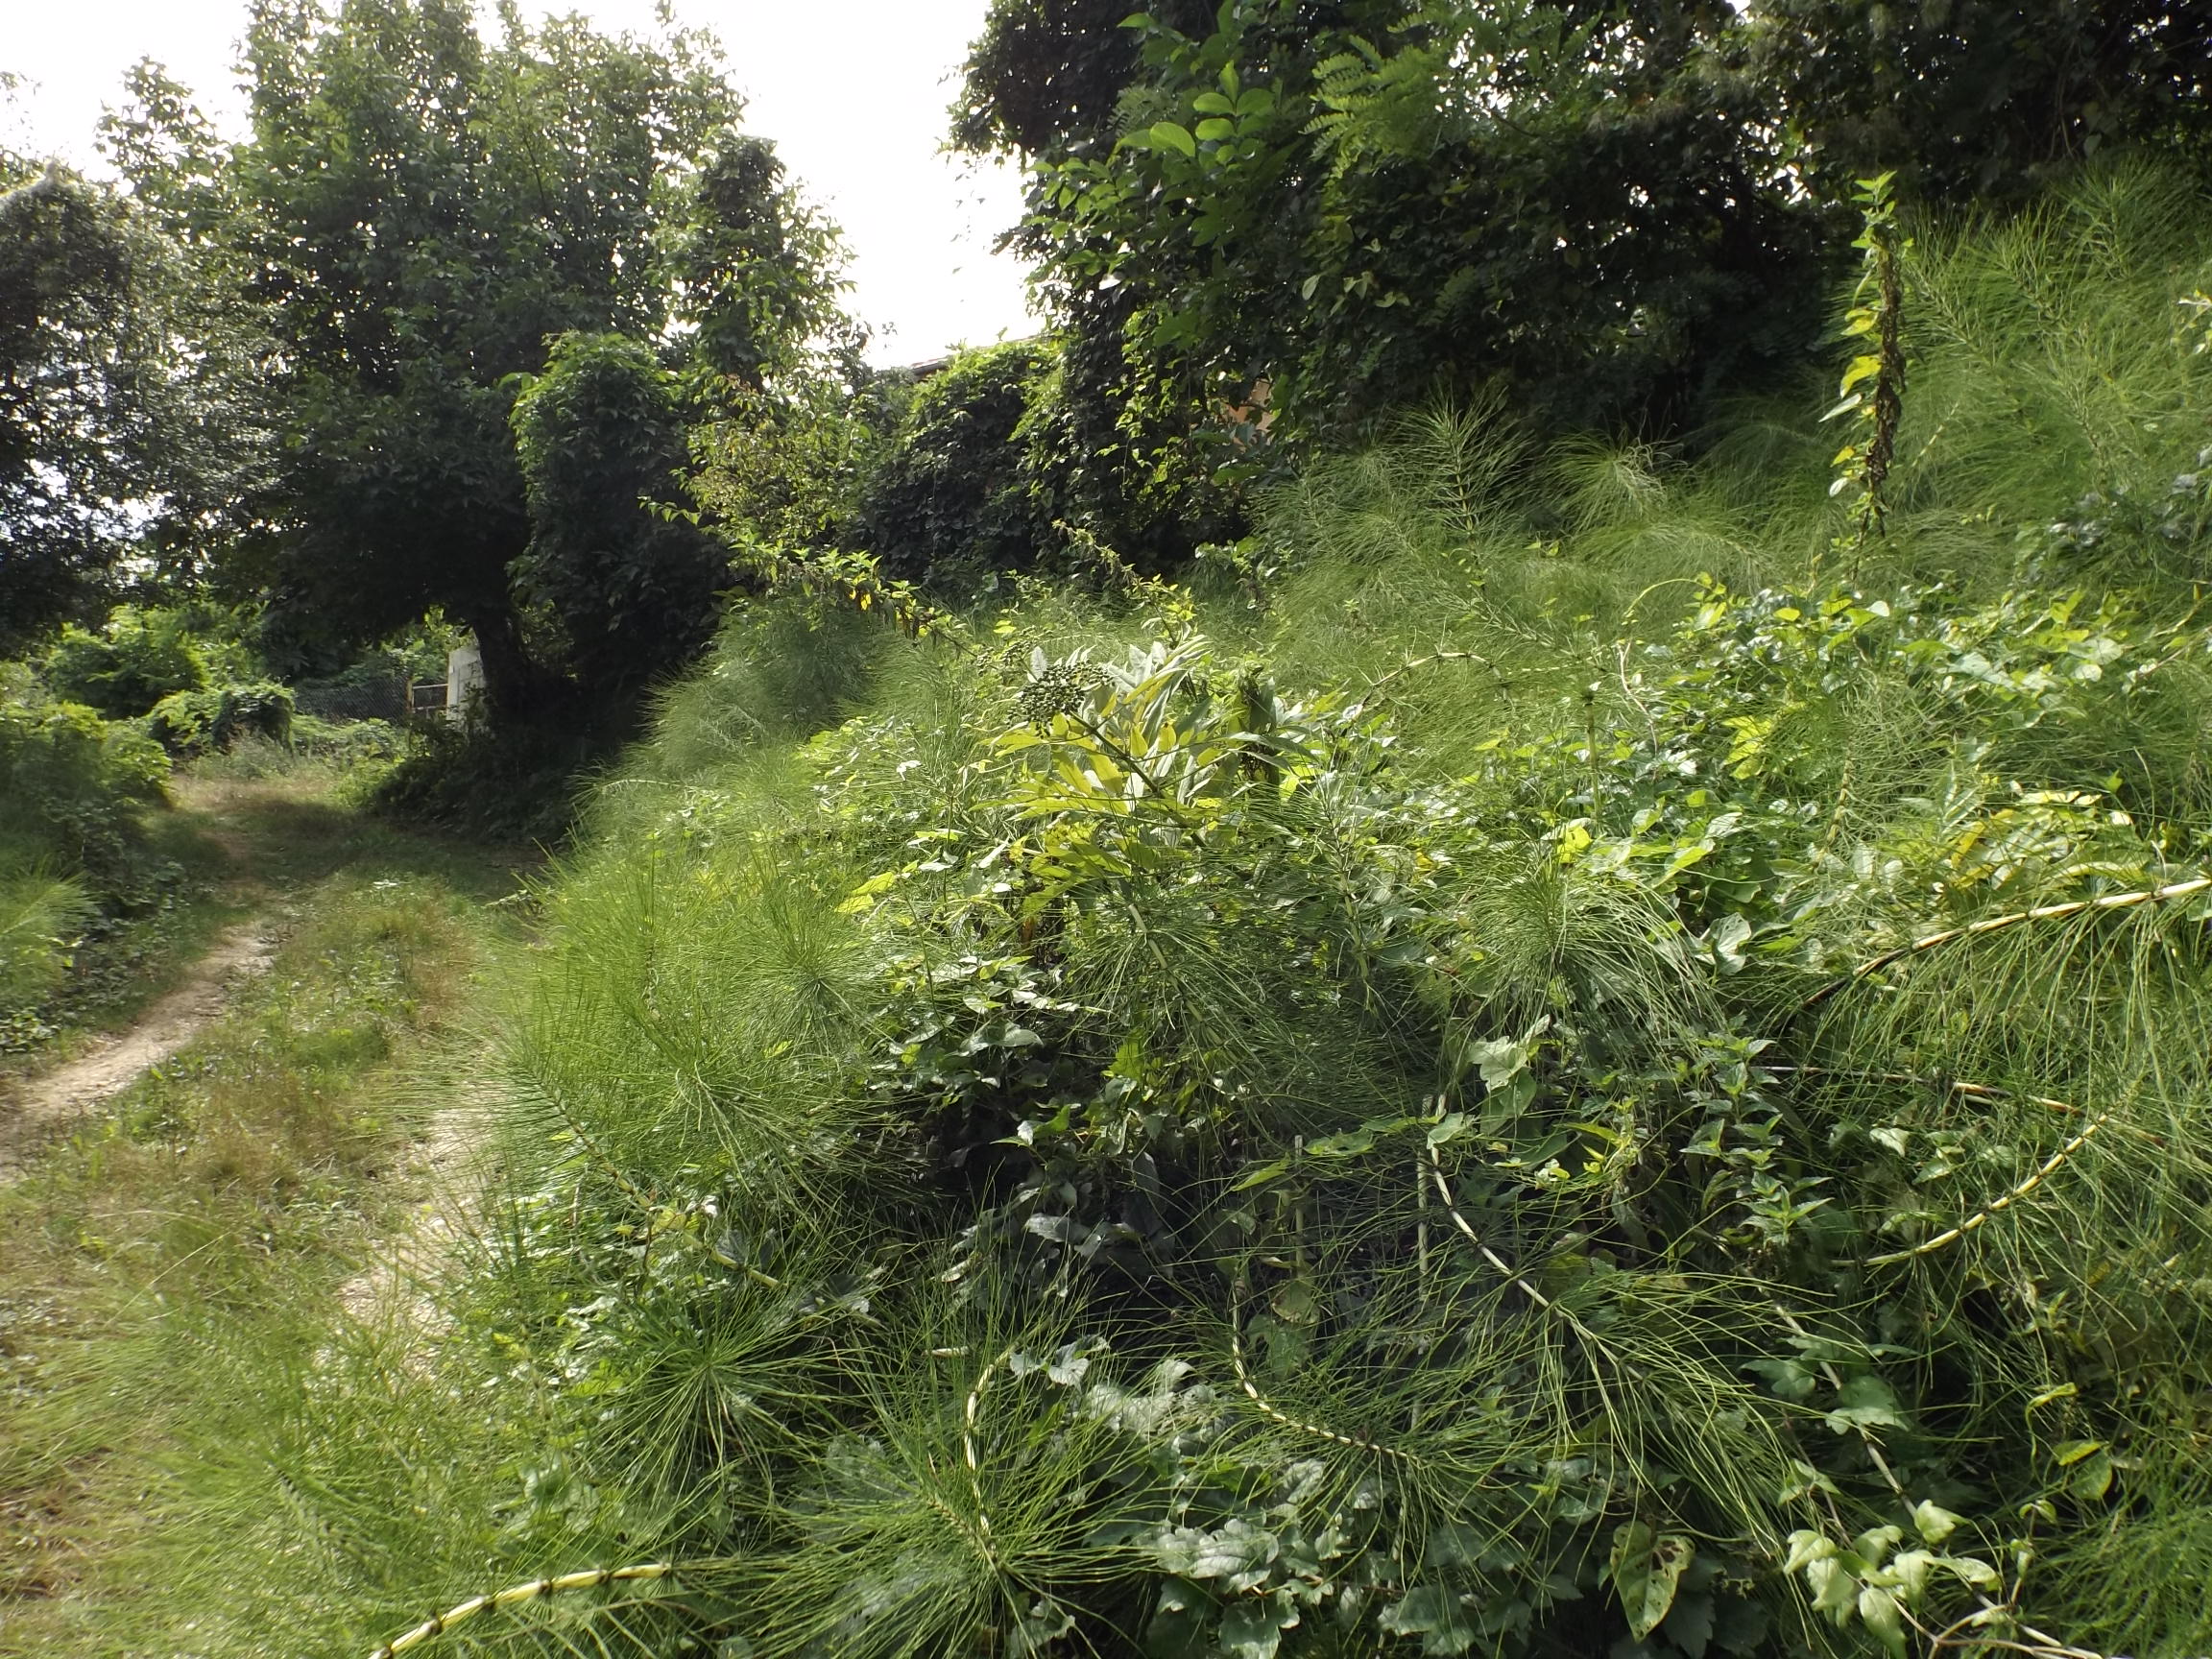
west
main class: Woodland
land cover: Broadleaved woodland
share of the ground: 50 - 75 %
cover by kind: broadleaved forest trees 65 %, herbaceous plants 25 %, shrubs 10 %
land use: Residential
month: August
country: BG
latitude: 43.2336
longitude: 27.9330
